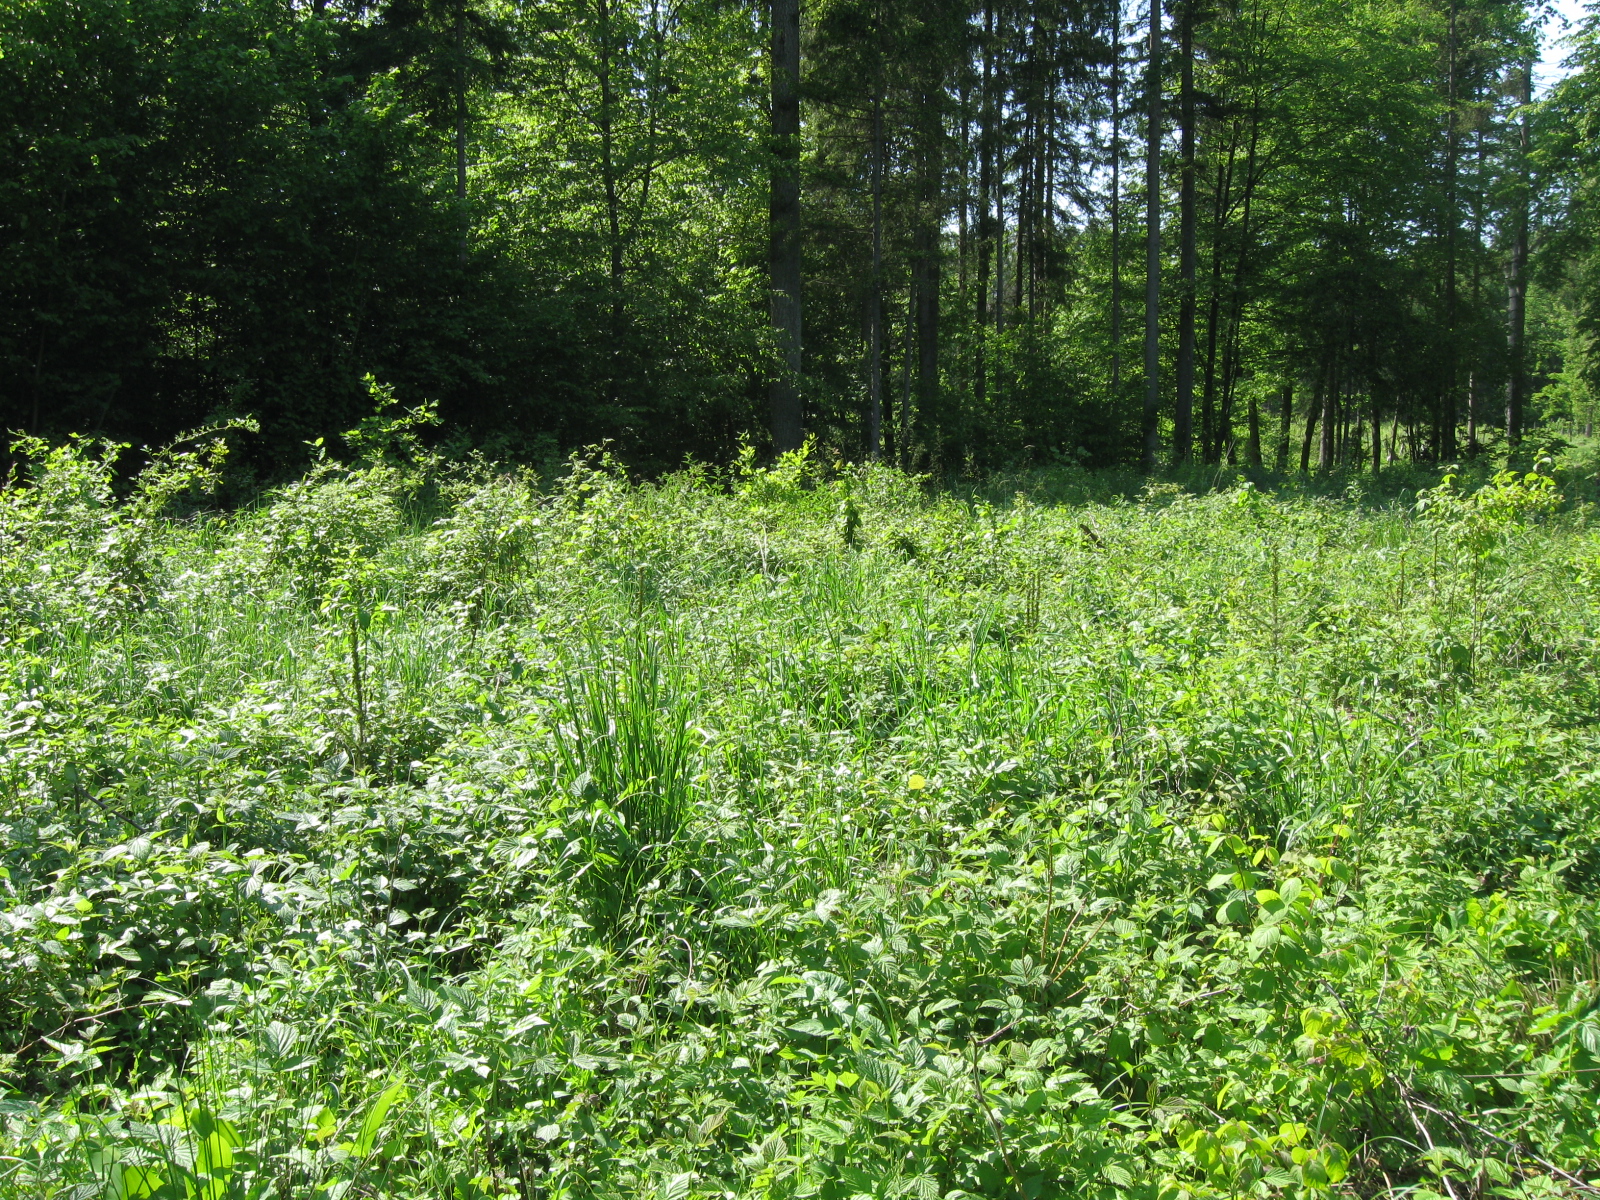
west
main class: Woodland
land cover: Broadleaved woodland
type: non-riverine alder, birch or aspen forest
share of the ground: 10 - 25 %
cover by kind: herbaceous plants 70 %, broadleaved forest trees 15 %, shrubs 10 %, coniferous forest trees 5 %
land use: Forestry
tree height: < 5 m
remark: Nursery
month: June
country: LT
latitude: 54.2682
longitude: 23.8000
